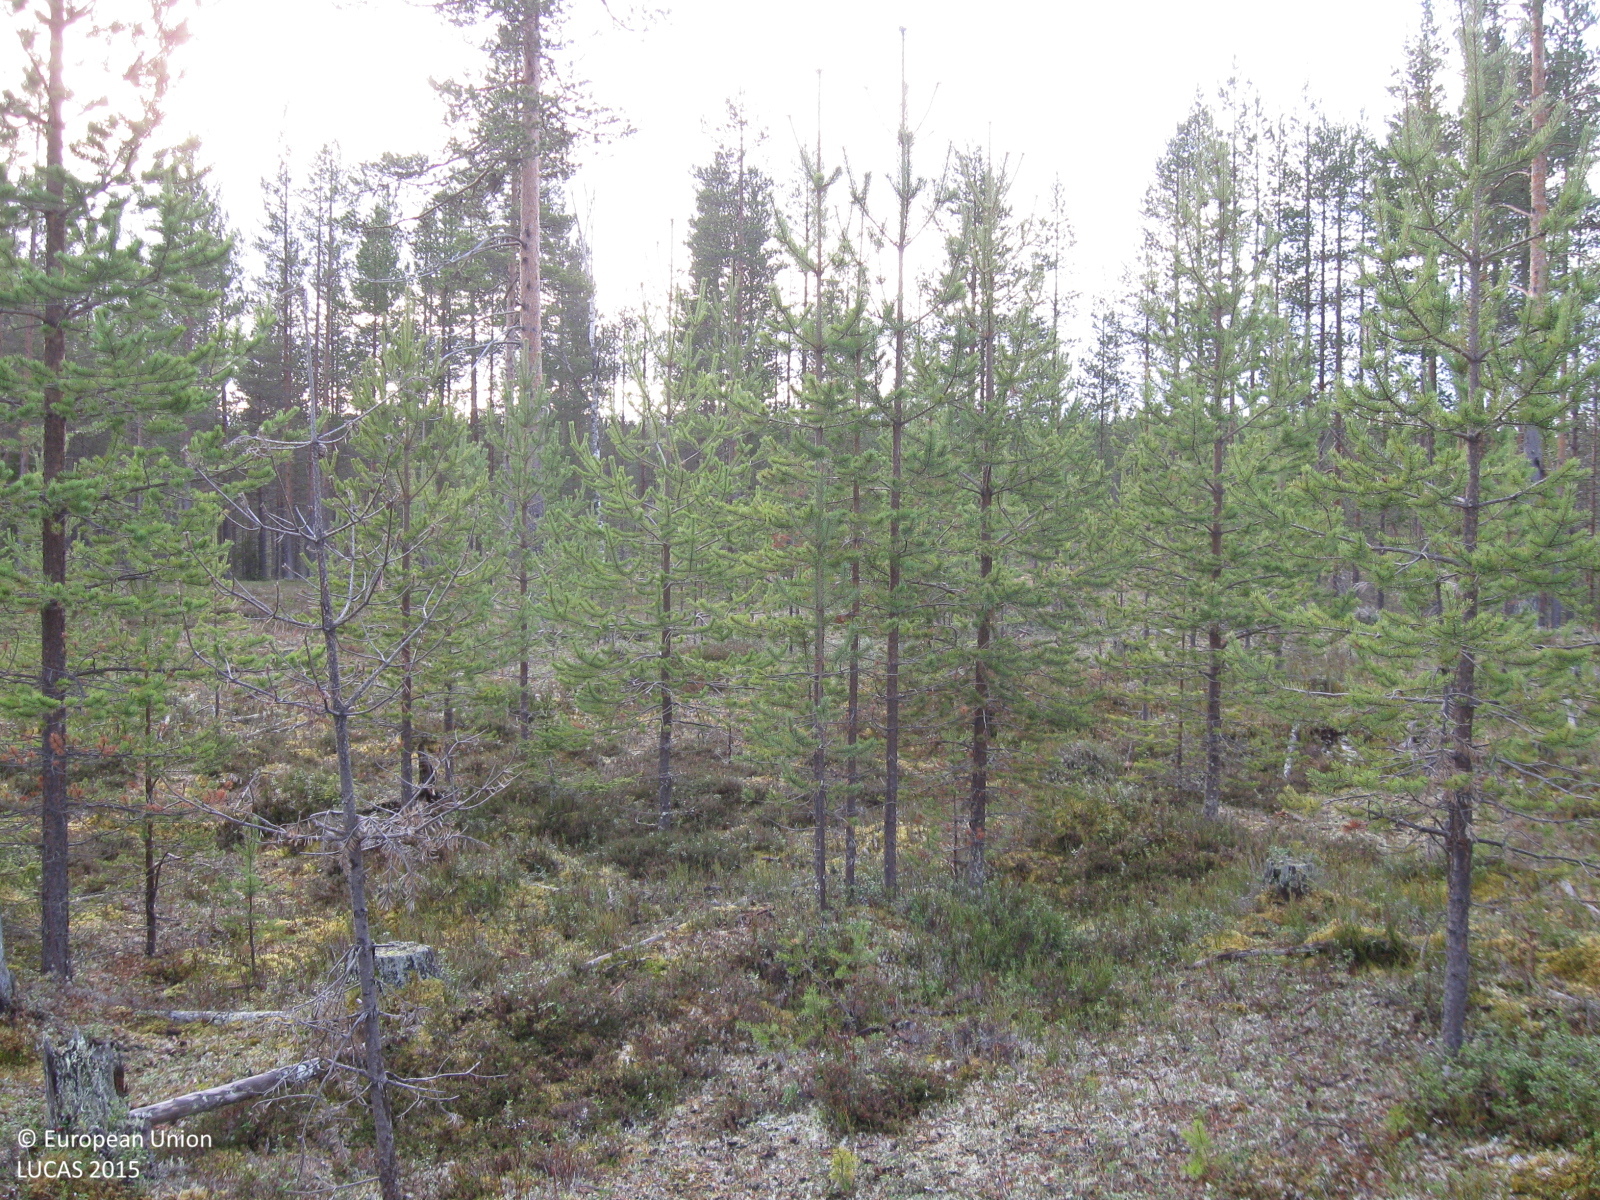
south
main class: Woodland
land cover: Pine dominated coniferous woodland
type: boreal forest
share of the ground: 50 - 75 %
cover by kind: coniferous forest trees 65 %, shrubs 15 %, lichens and mosses 10 %, herbaceous plants 5 %
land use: Forestry
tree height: < 5 m
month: November
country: SE
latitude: 66.0532
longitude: 20.5817
